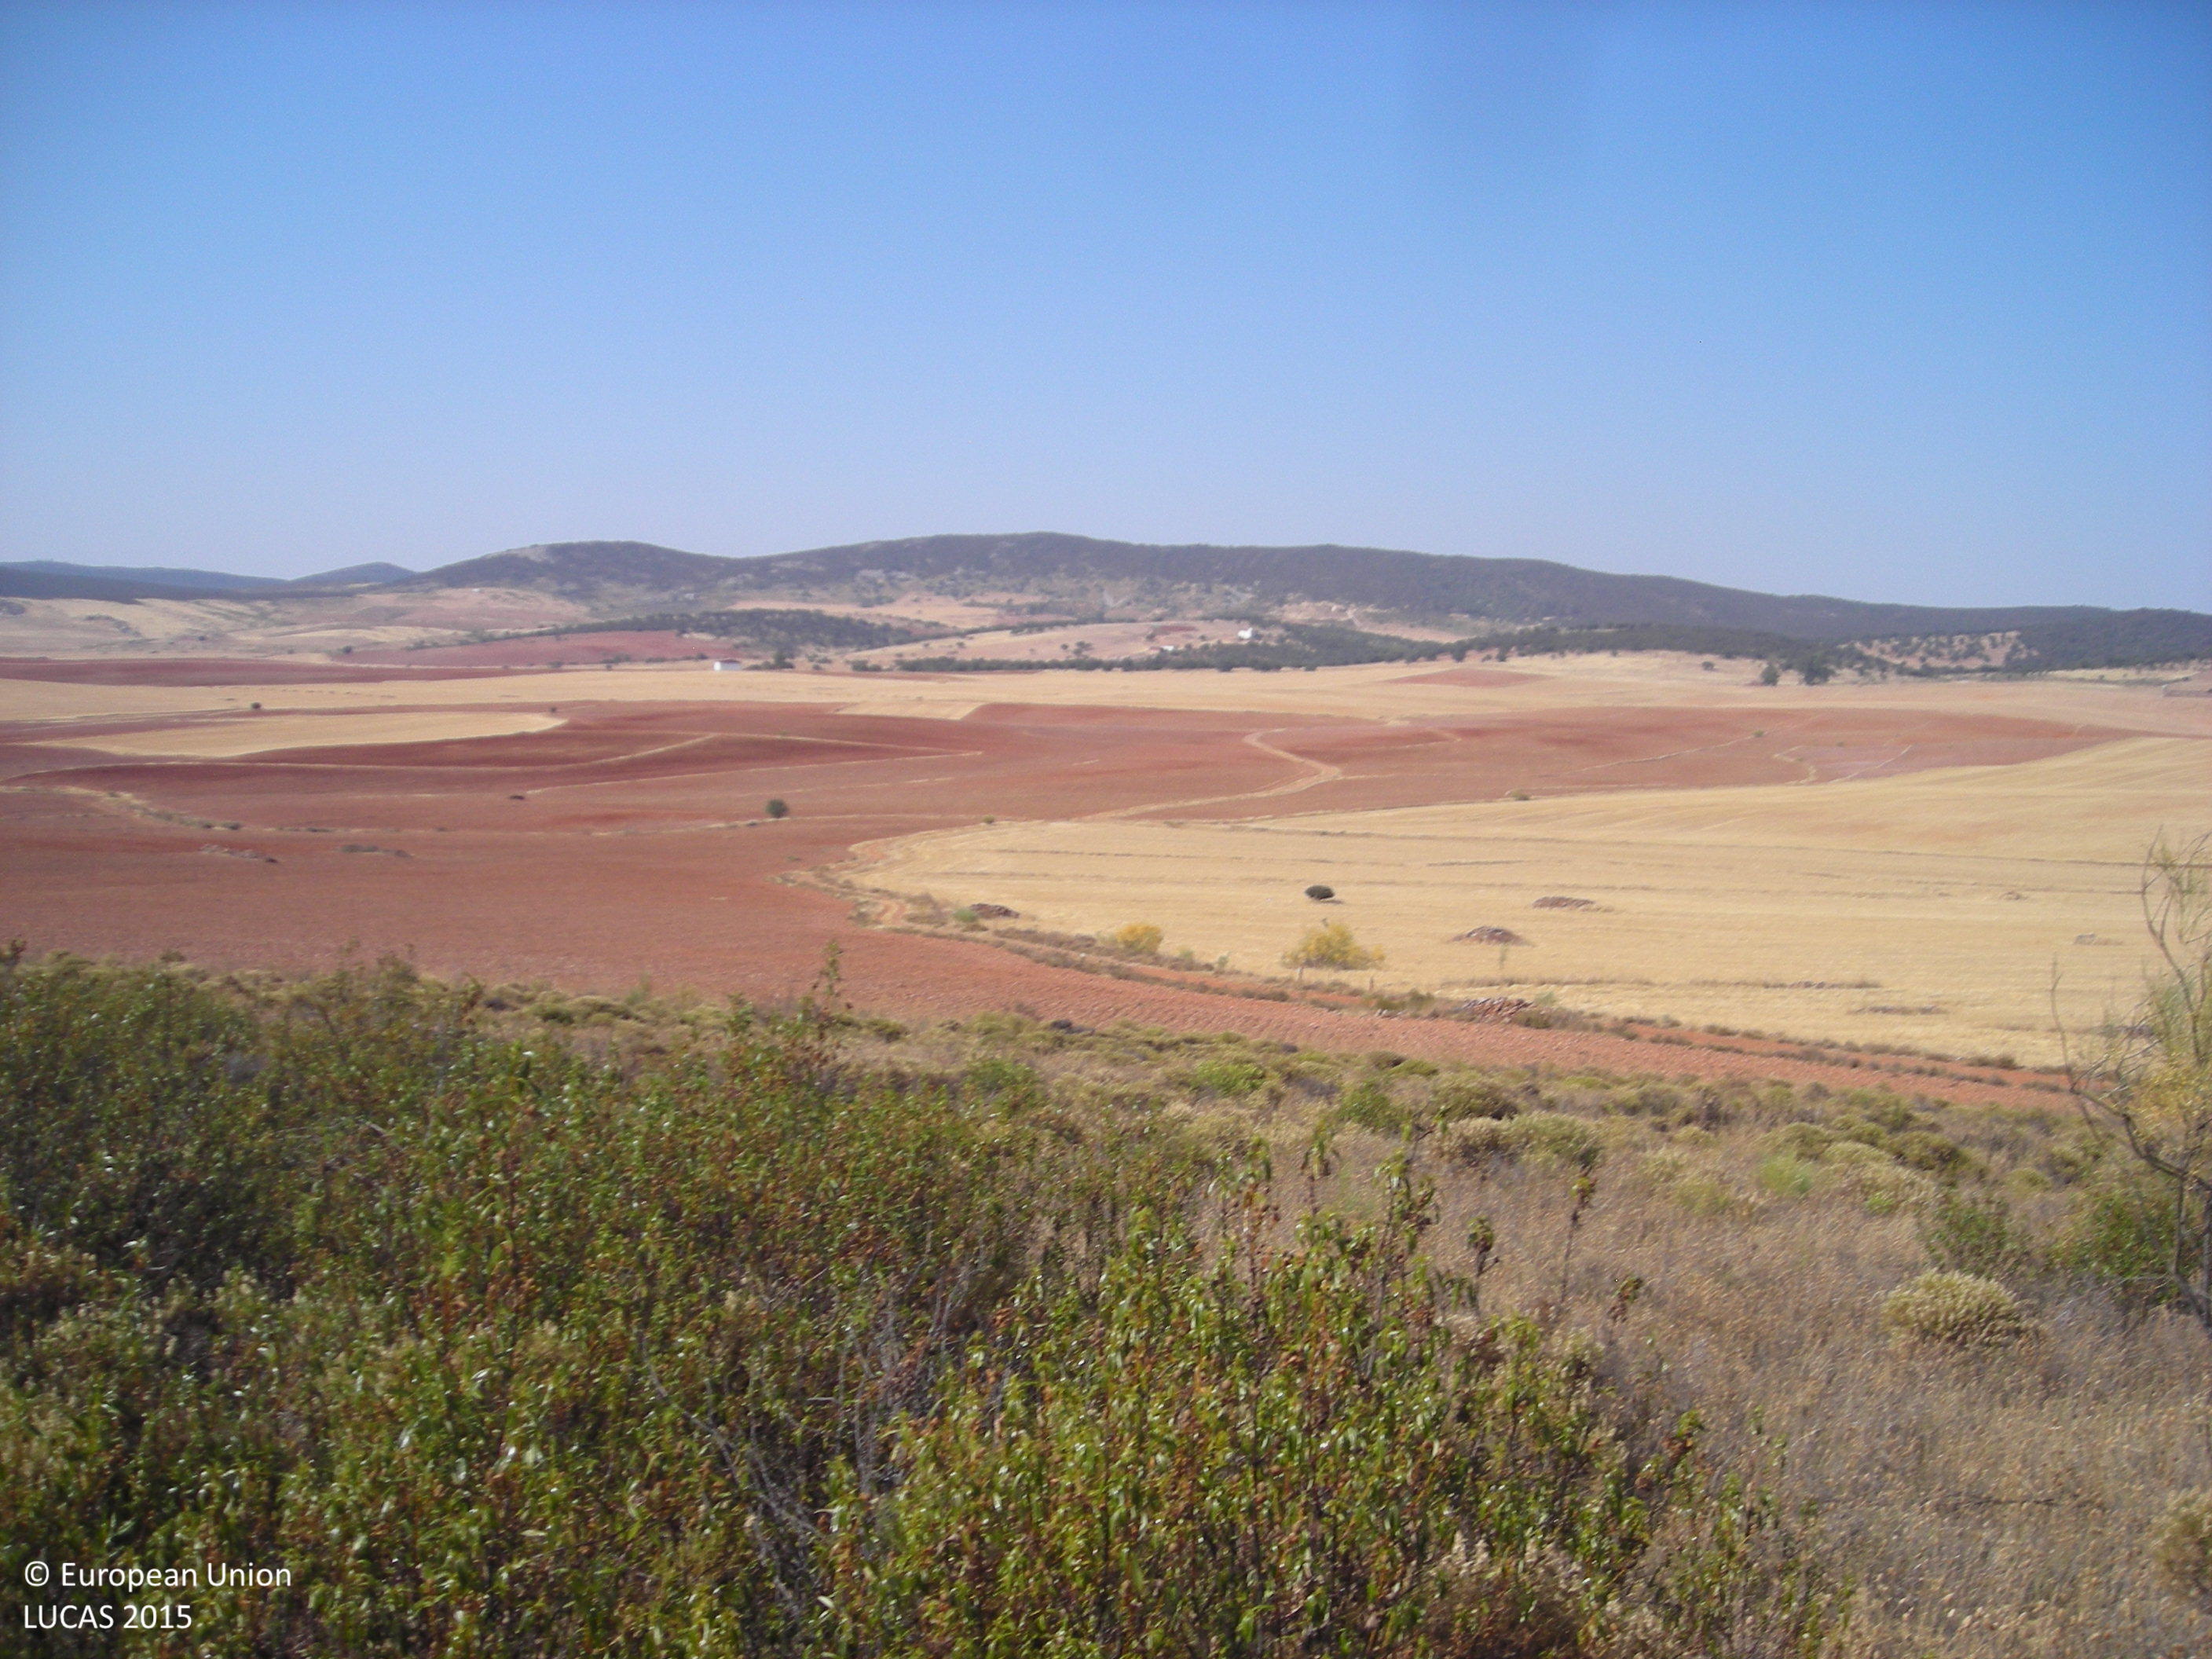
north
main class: Shrubland
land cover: Shrubland without tree cover
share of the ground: > 75 %
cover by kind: shrubs 100 %
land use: Semi-natural and natural areas not in use
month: July
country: ES
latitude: 38.7220
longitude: -5.7901
